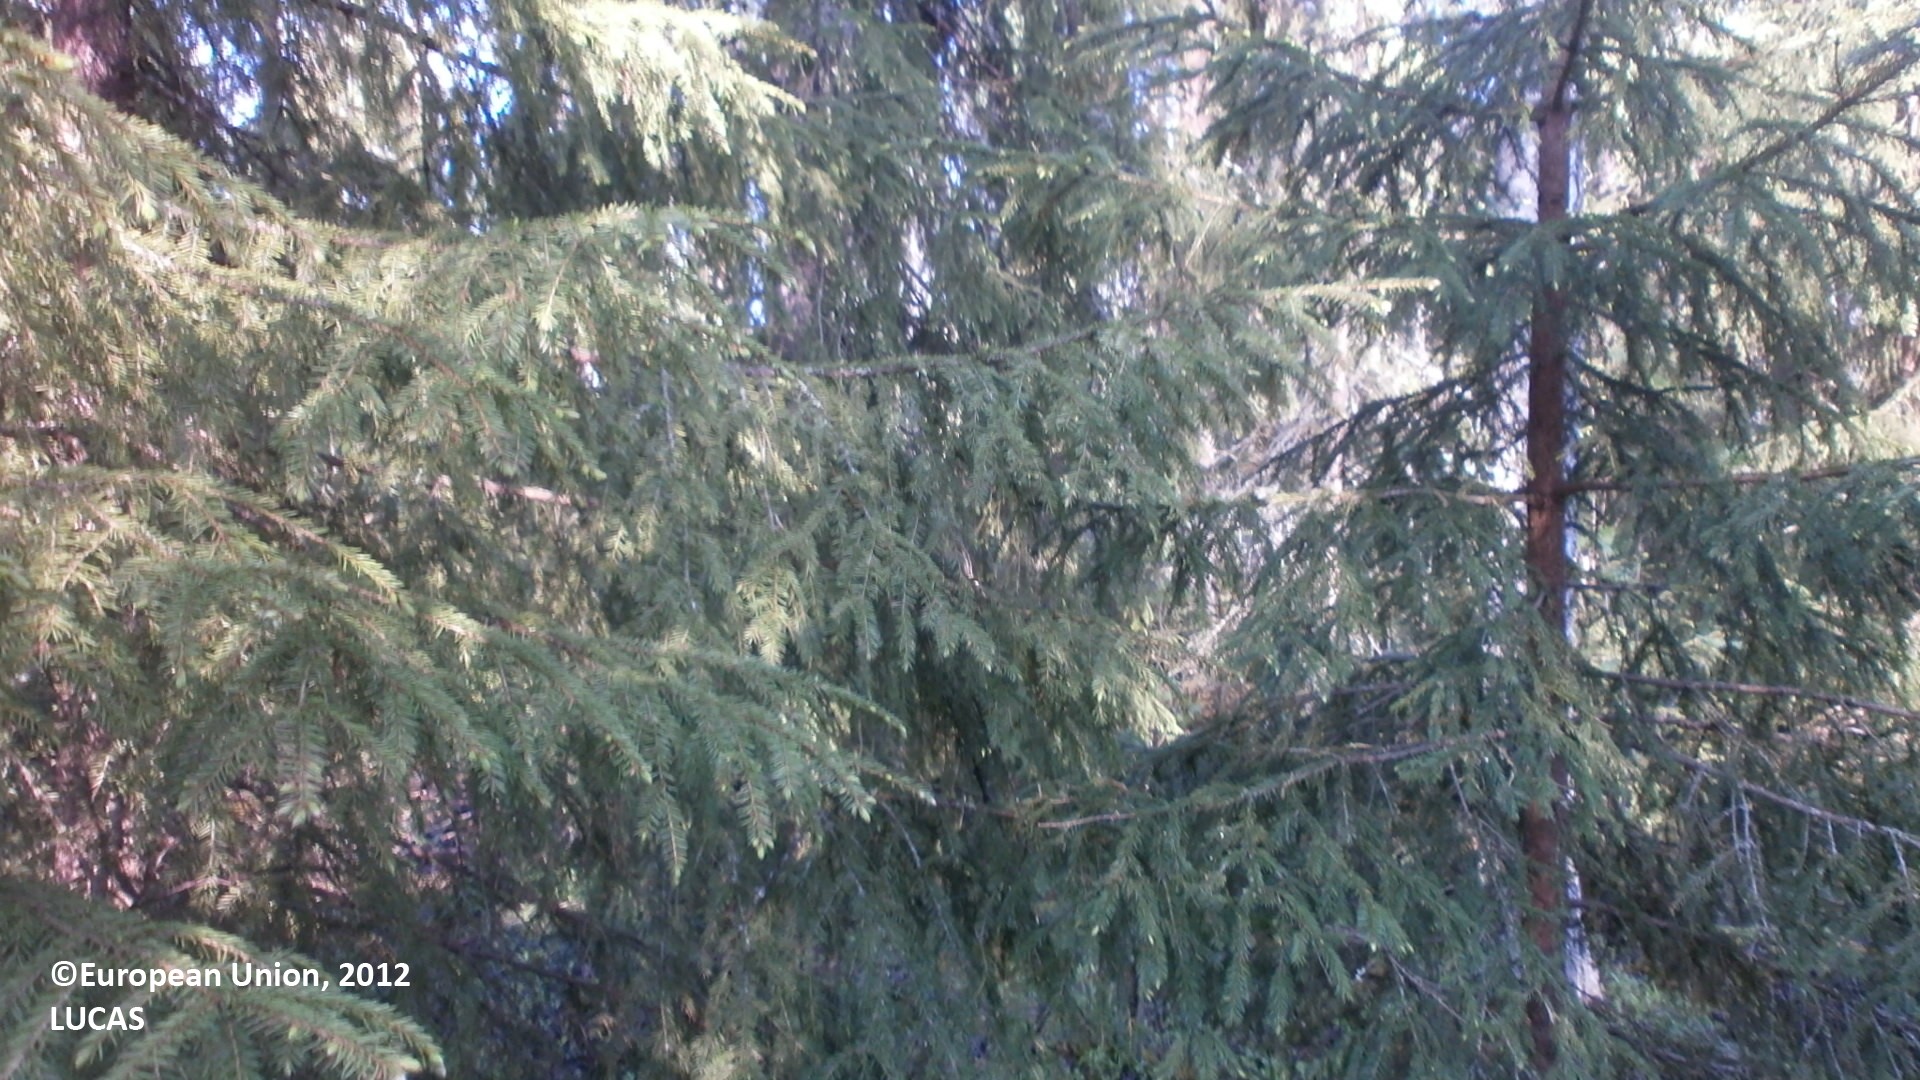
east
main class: Woodland
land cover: Spruce dominated mixed woodland
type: mire and swamp forests
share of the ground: 50 - 75 %
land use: Forestry
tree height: > 5 m
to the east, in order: Spruce dominated mixed woodland; Other mixed woodland; Shrubland with sparse tree cover; Other mixed woodland; Ditches and canals; Pine dominated mixed woodland; Ditches and canals; Other mixed woodland; Ditches and canals; Pine dominated mixed woodland; Other mixed woodland; Broadleaved woodland; Ditches and canals; Grassland without tree/shrub cover; Ditches and canals; Grassland without tree/shrub cover; Ditches and canals; Other mixed woodland
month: June
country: FI
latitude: 64.5989
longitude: 25.2309
